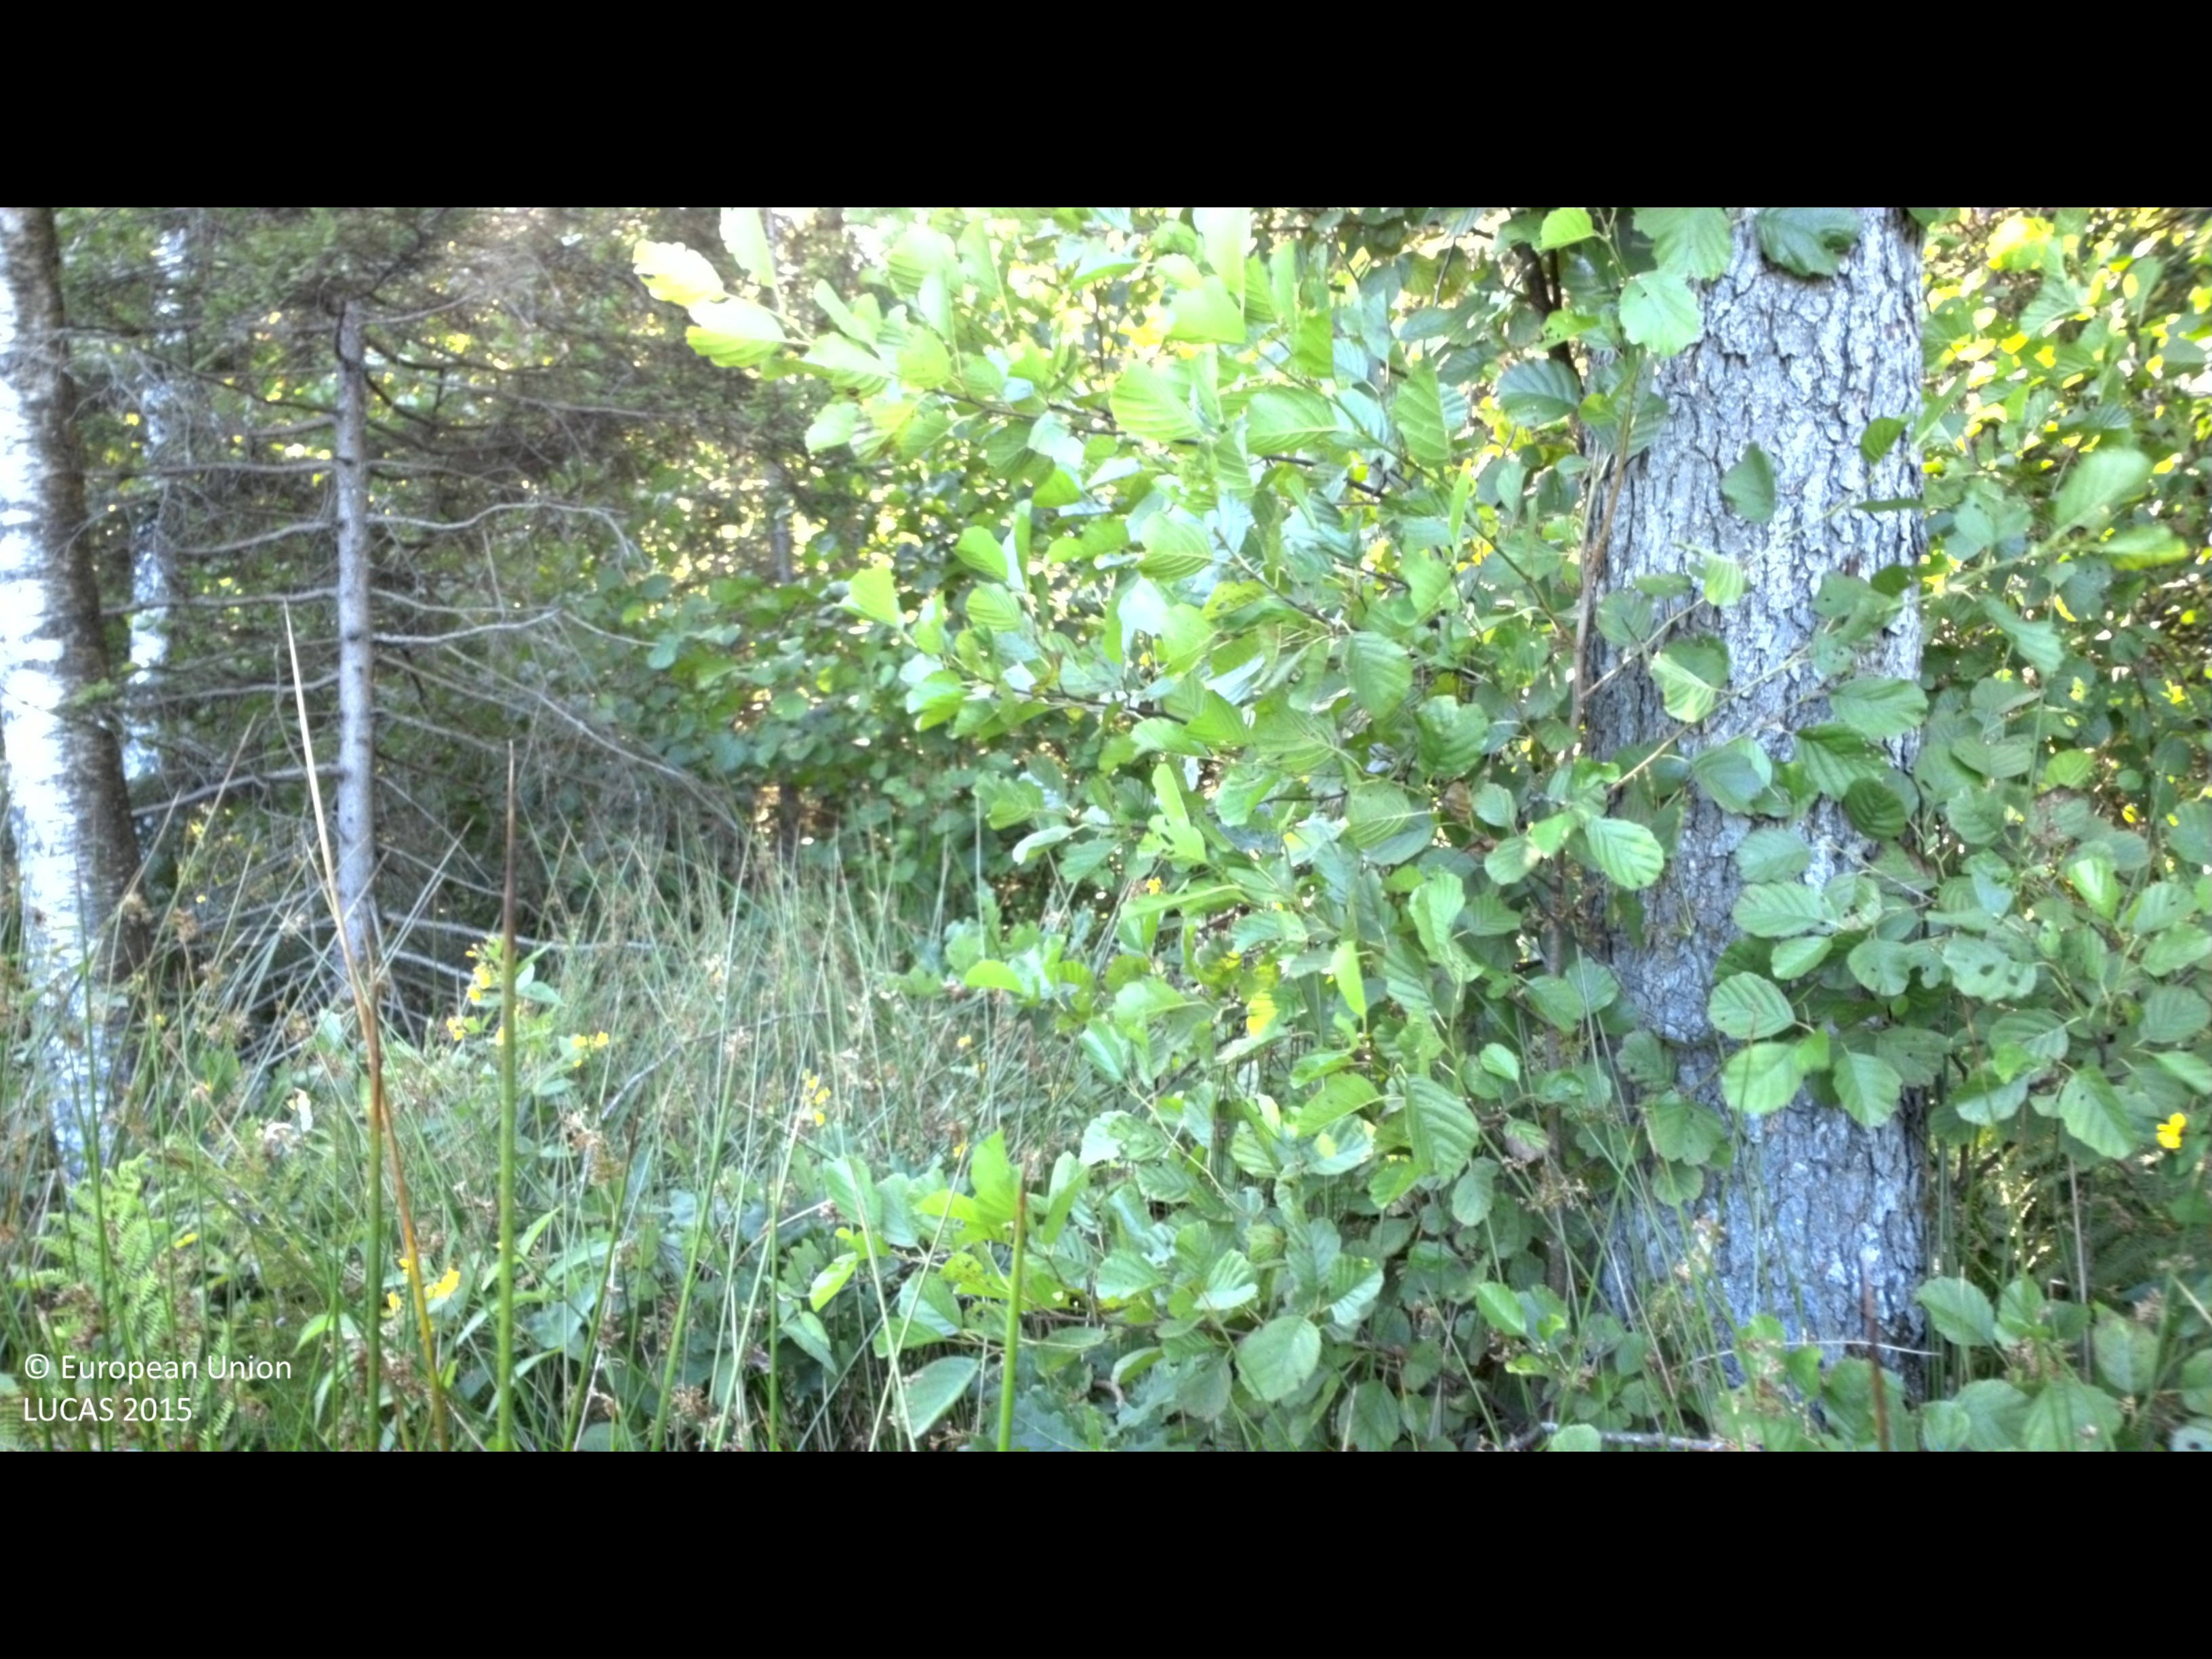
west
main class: Woodland
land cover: Spruce dominated mixed woodland
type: hemiboreal forest and nemoral coniferous forest and mixed broadleaved-coniferous forest
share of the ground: > 75 %
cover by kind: coniferous forest trees 50 %, broadleaved forest trees 25 %, herbaceous plants 20 %, shrubs 5 %
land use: Forestry
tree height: > 5 m
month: August
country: SE
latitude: 56.2979
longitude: 15.2183
